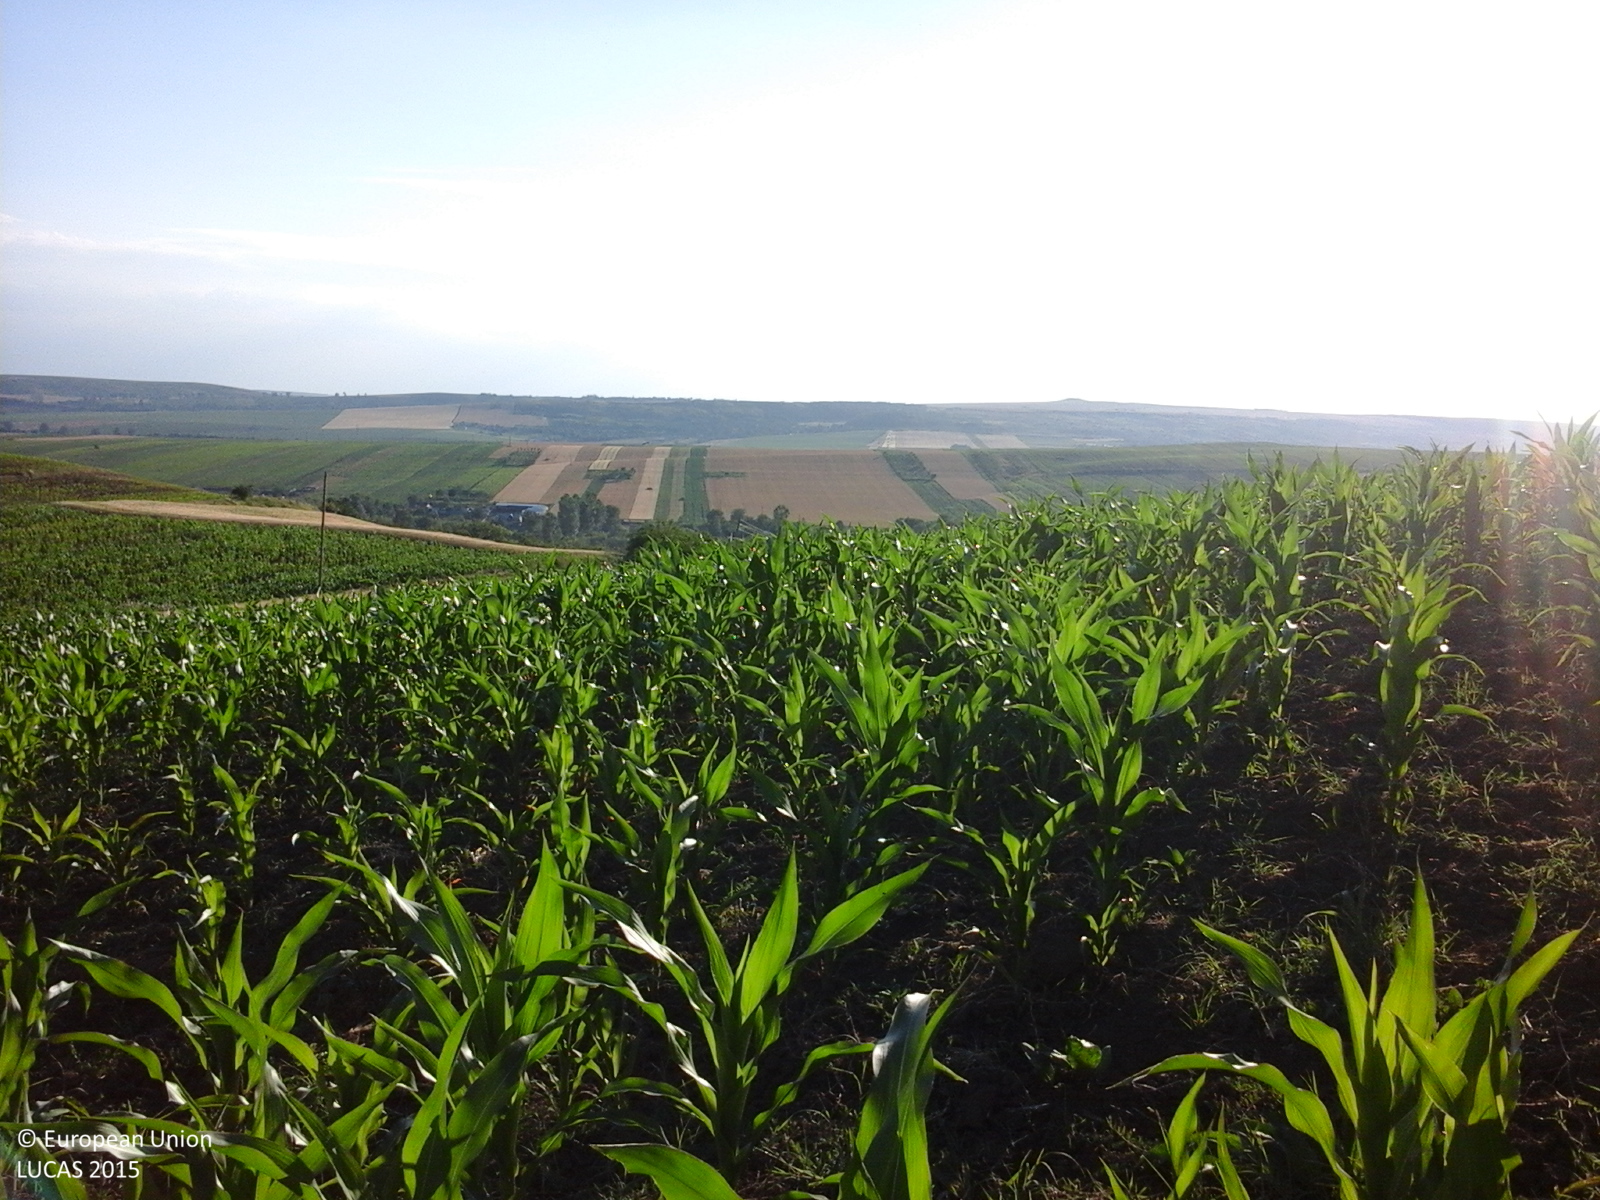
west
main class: Cropland
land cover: Maize
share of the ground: > 75 %
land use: Agriculture (excluding fallow land and kitchen gardens)
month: June
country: RO
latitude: 46.9394
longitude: 27.6017
